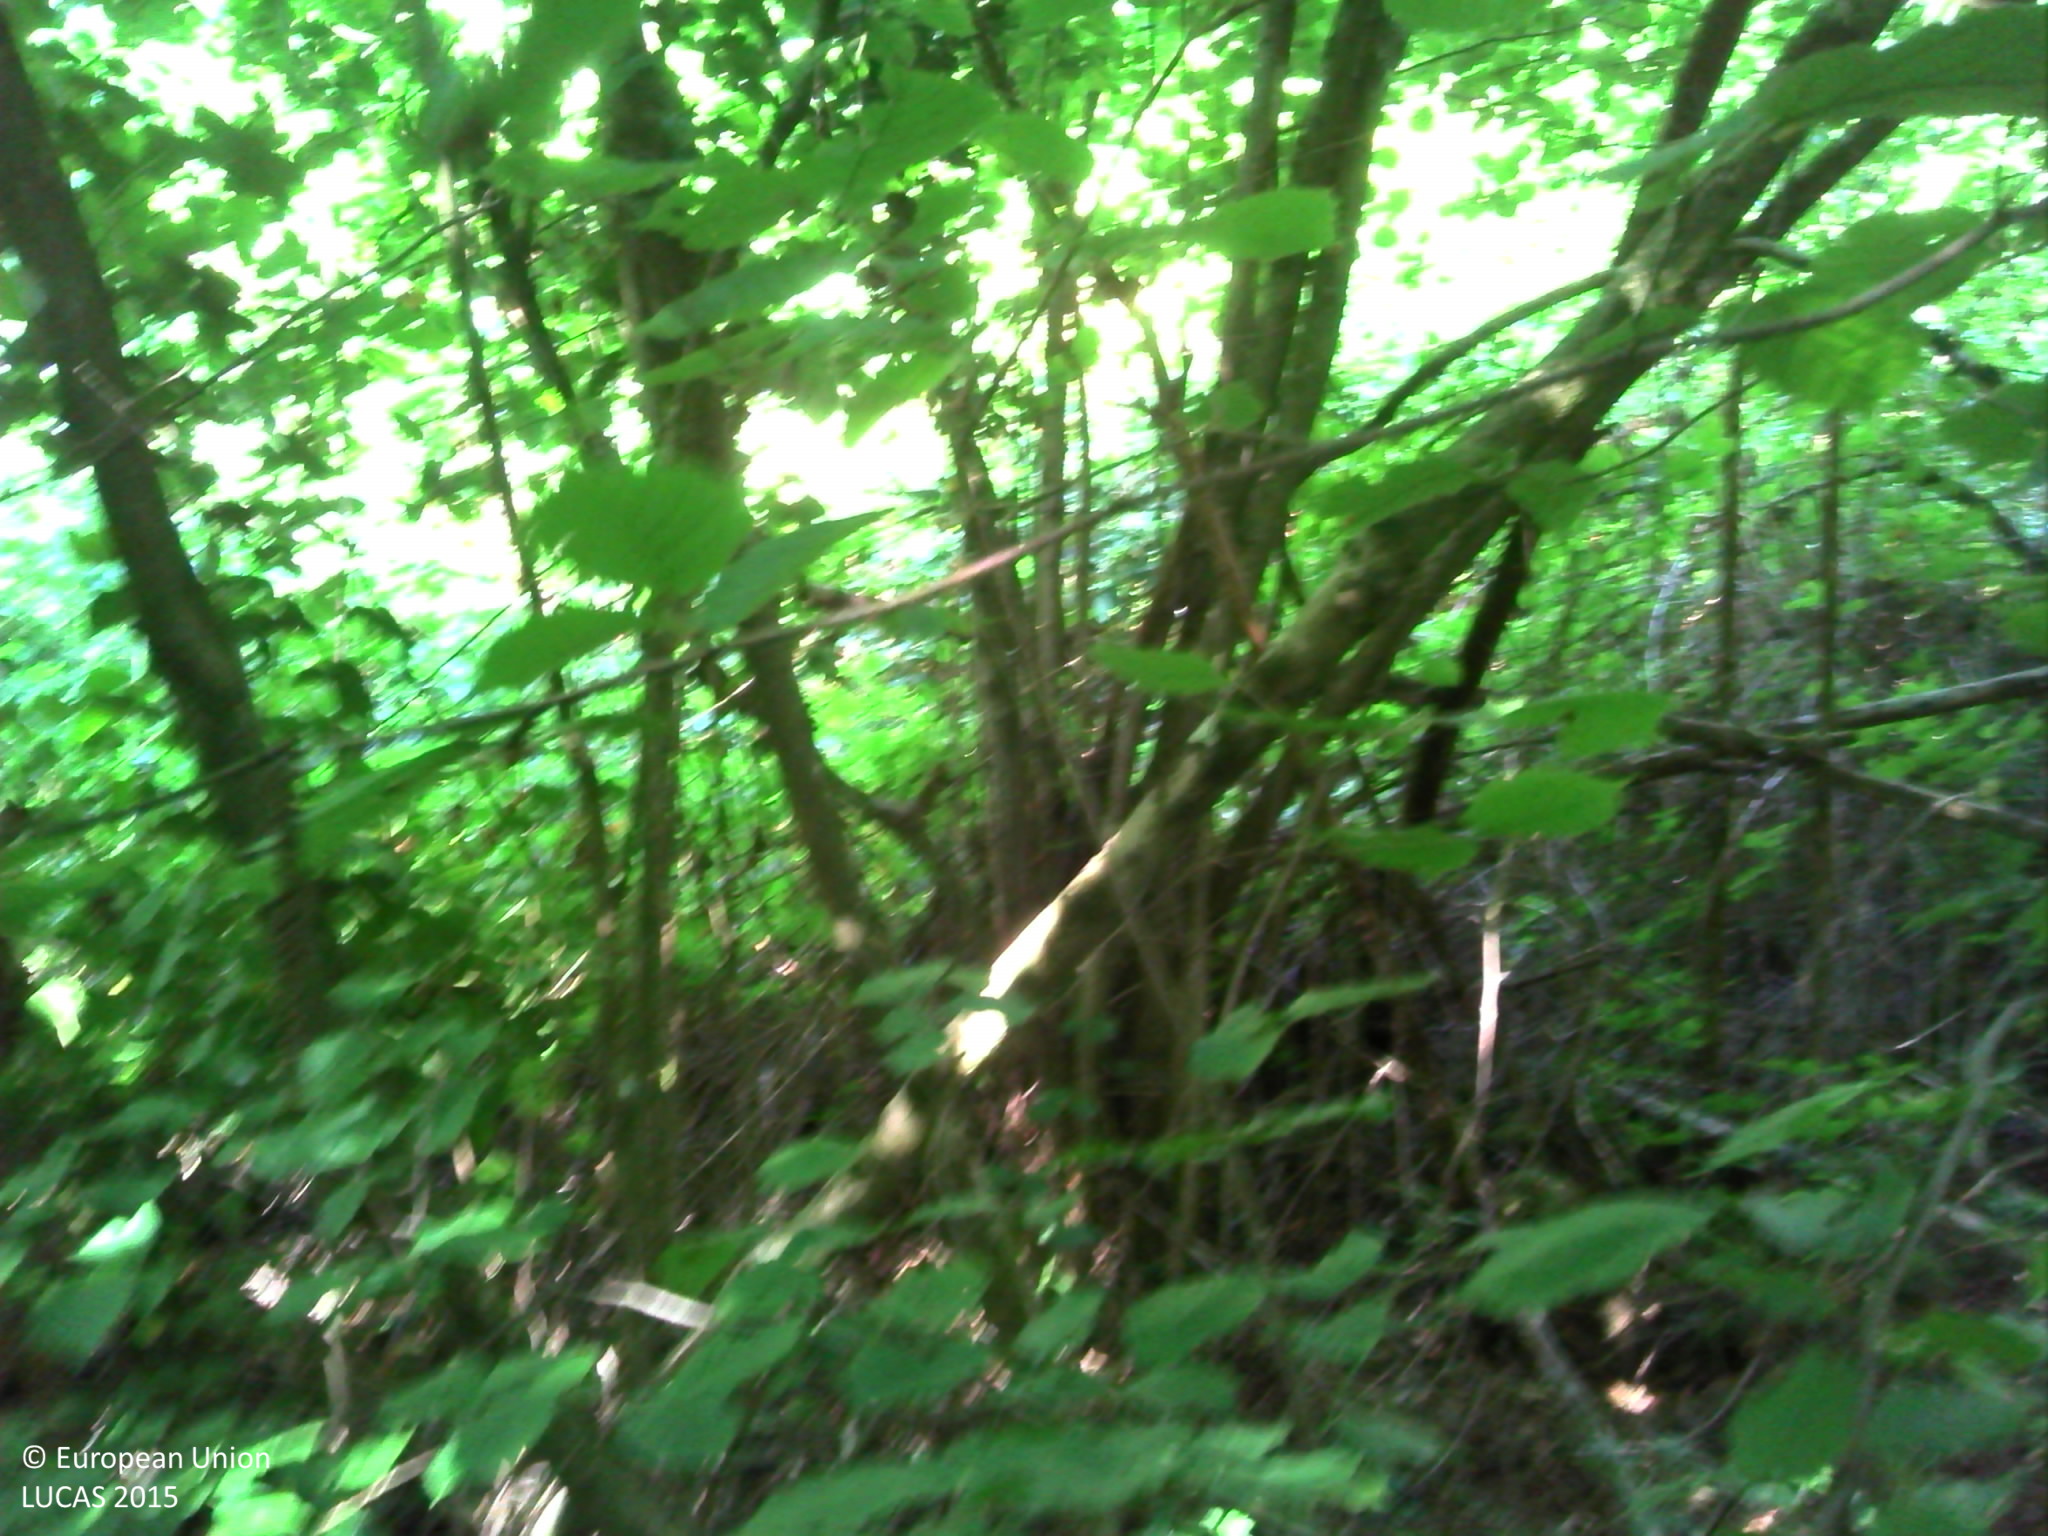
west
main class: Woodland
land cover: Broadleaved woodland
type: non-riverine alder, birch or aspen forest
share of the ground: > 75 %
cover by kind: broadleaved forest trees 95 %, herbaceous plants 5 %
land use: Semi-natural and natural areas not in use
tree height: > 5 m
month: July
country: FR
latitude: 47.6772
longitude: -1.8093
